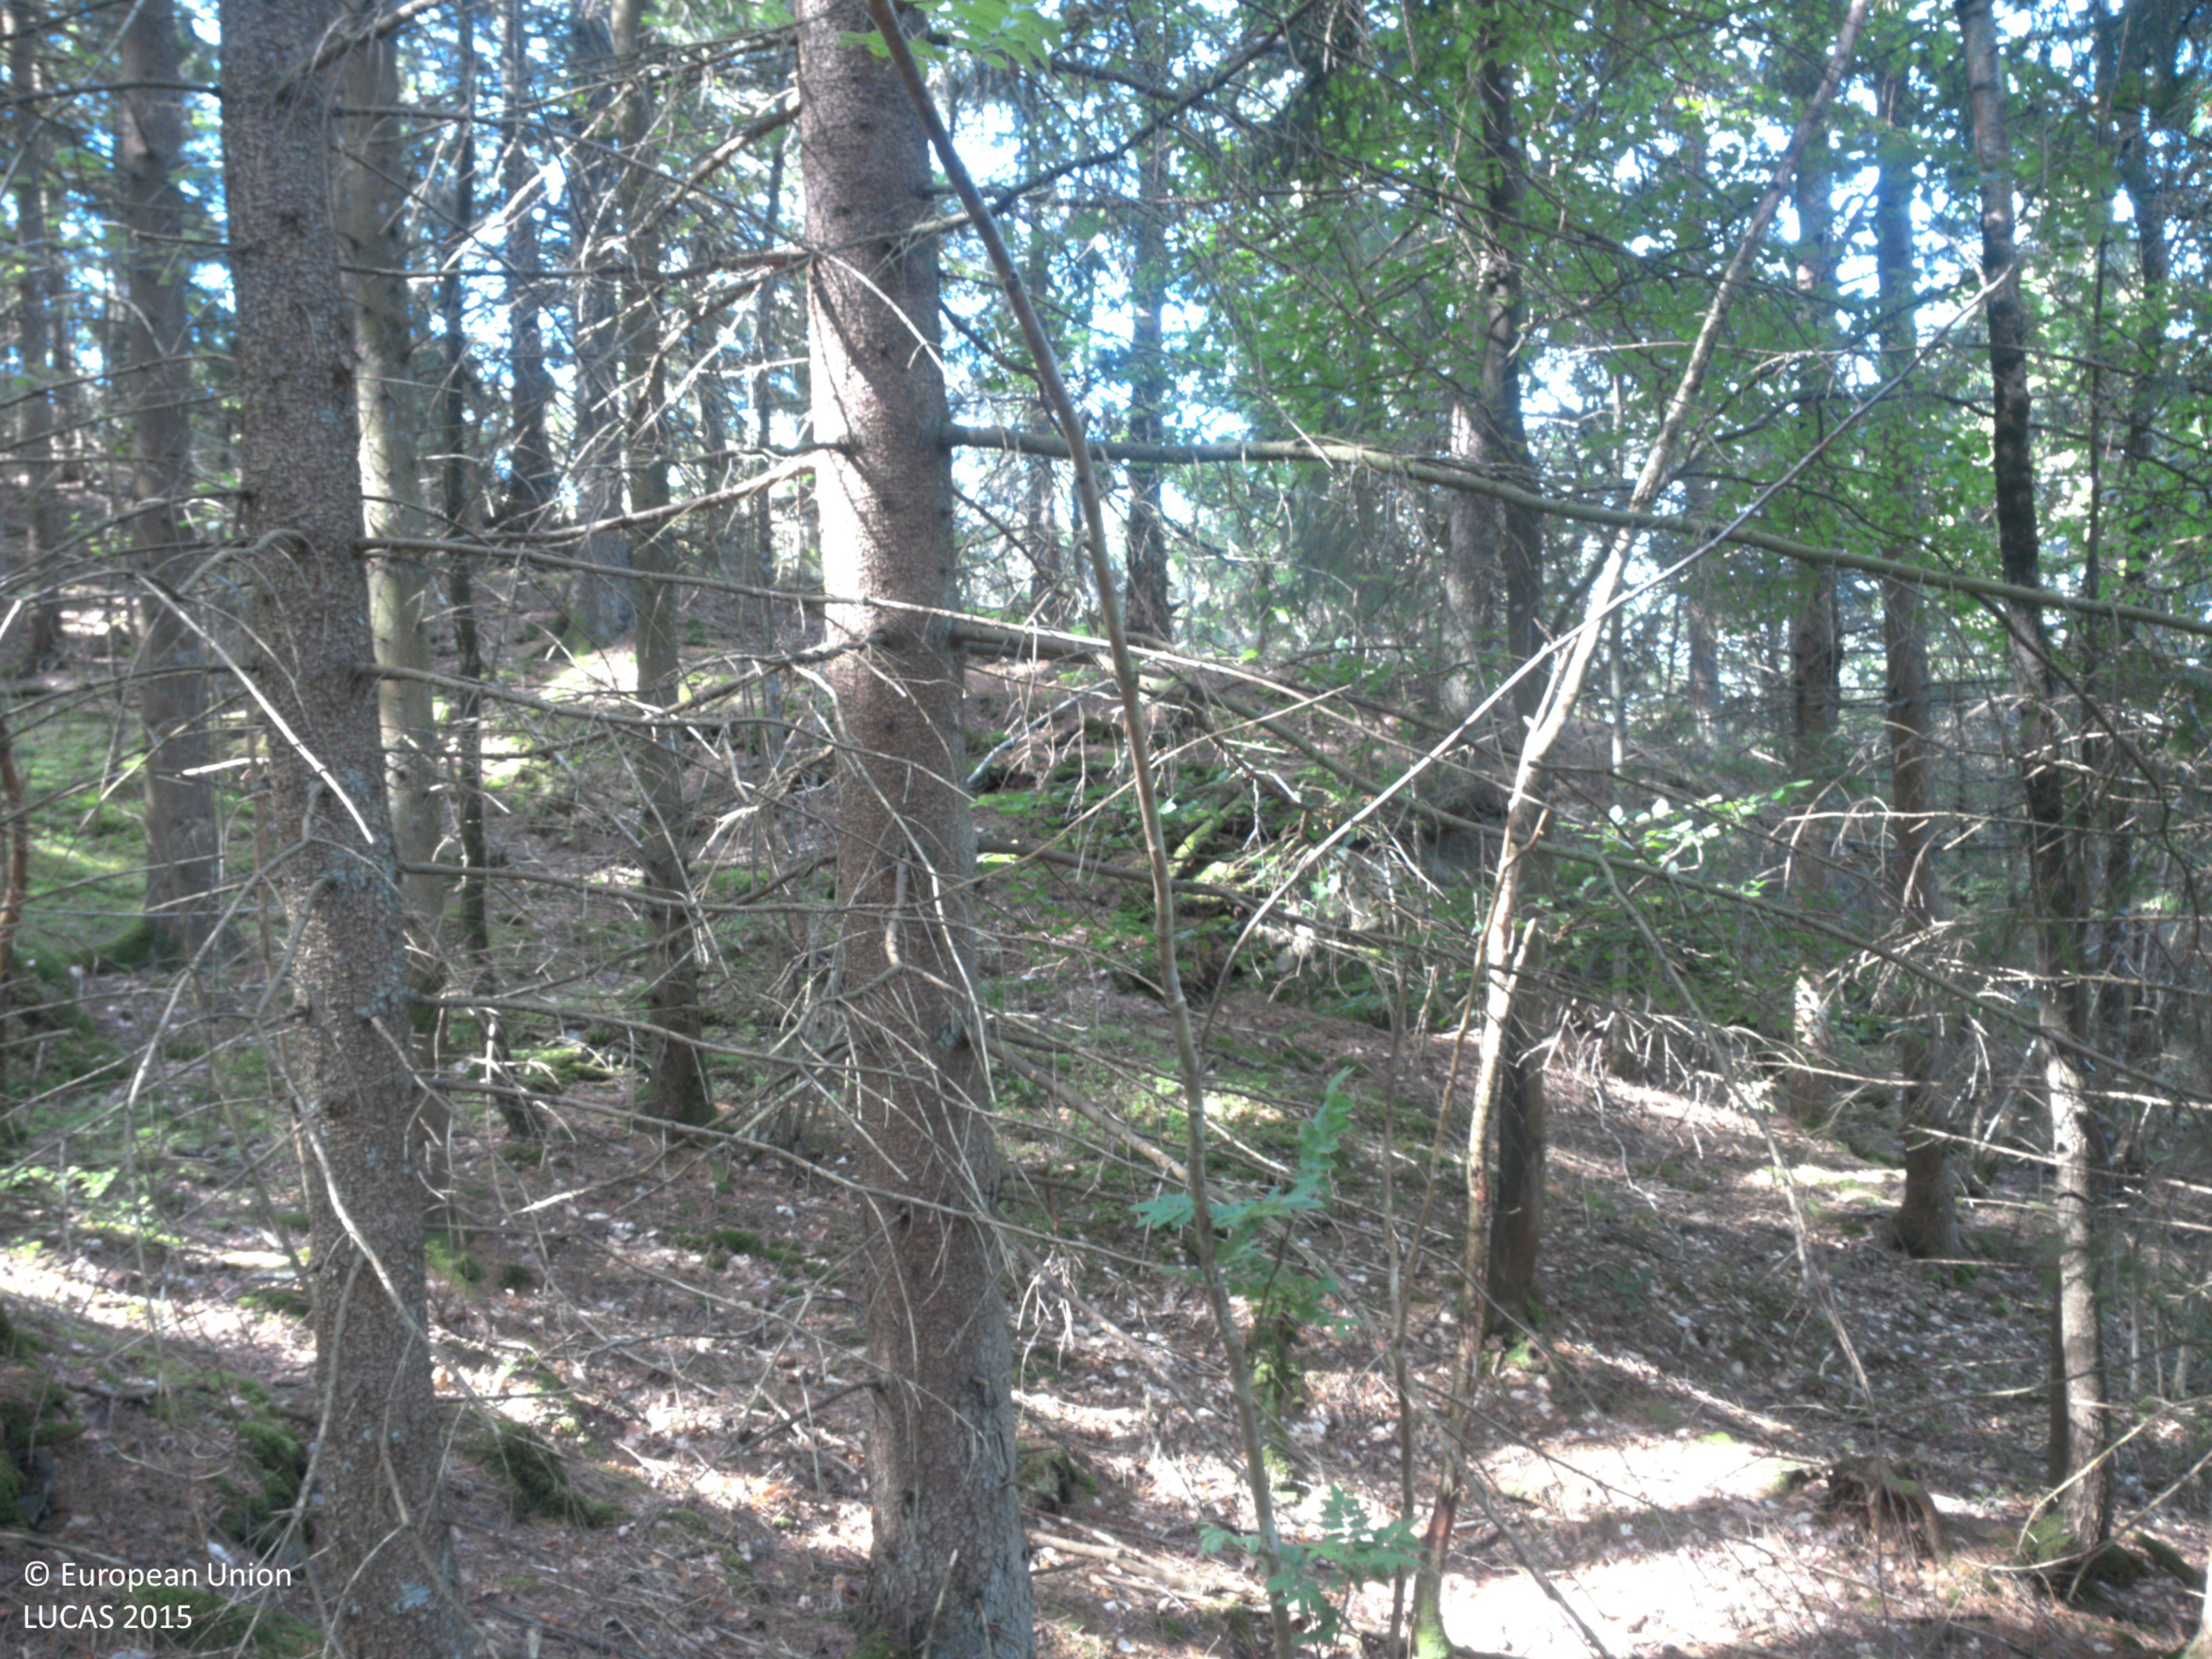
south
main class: Woodland
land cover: Spruce dominated mixed woodland
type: boreal forest
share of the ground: > 75 %
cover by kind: coniferous forest trees 55 %, broadleaved forest trees 25 %, lichens and mosses 20 %
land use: Forestry
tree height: > 5 m
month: June
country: SE
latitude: 58.4439
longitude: 11.5899
